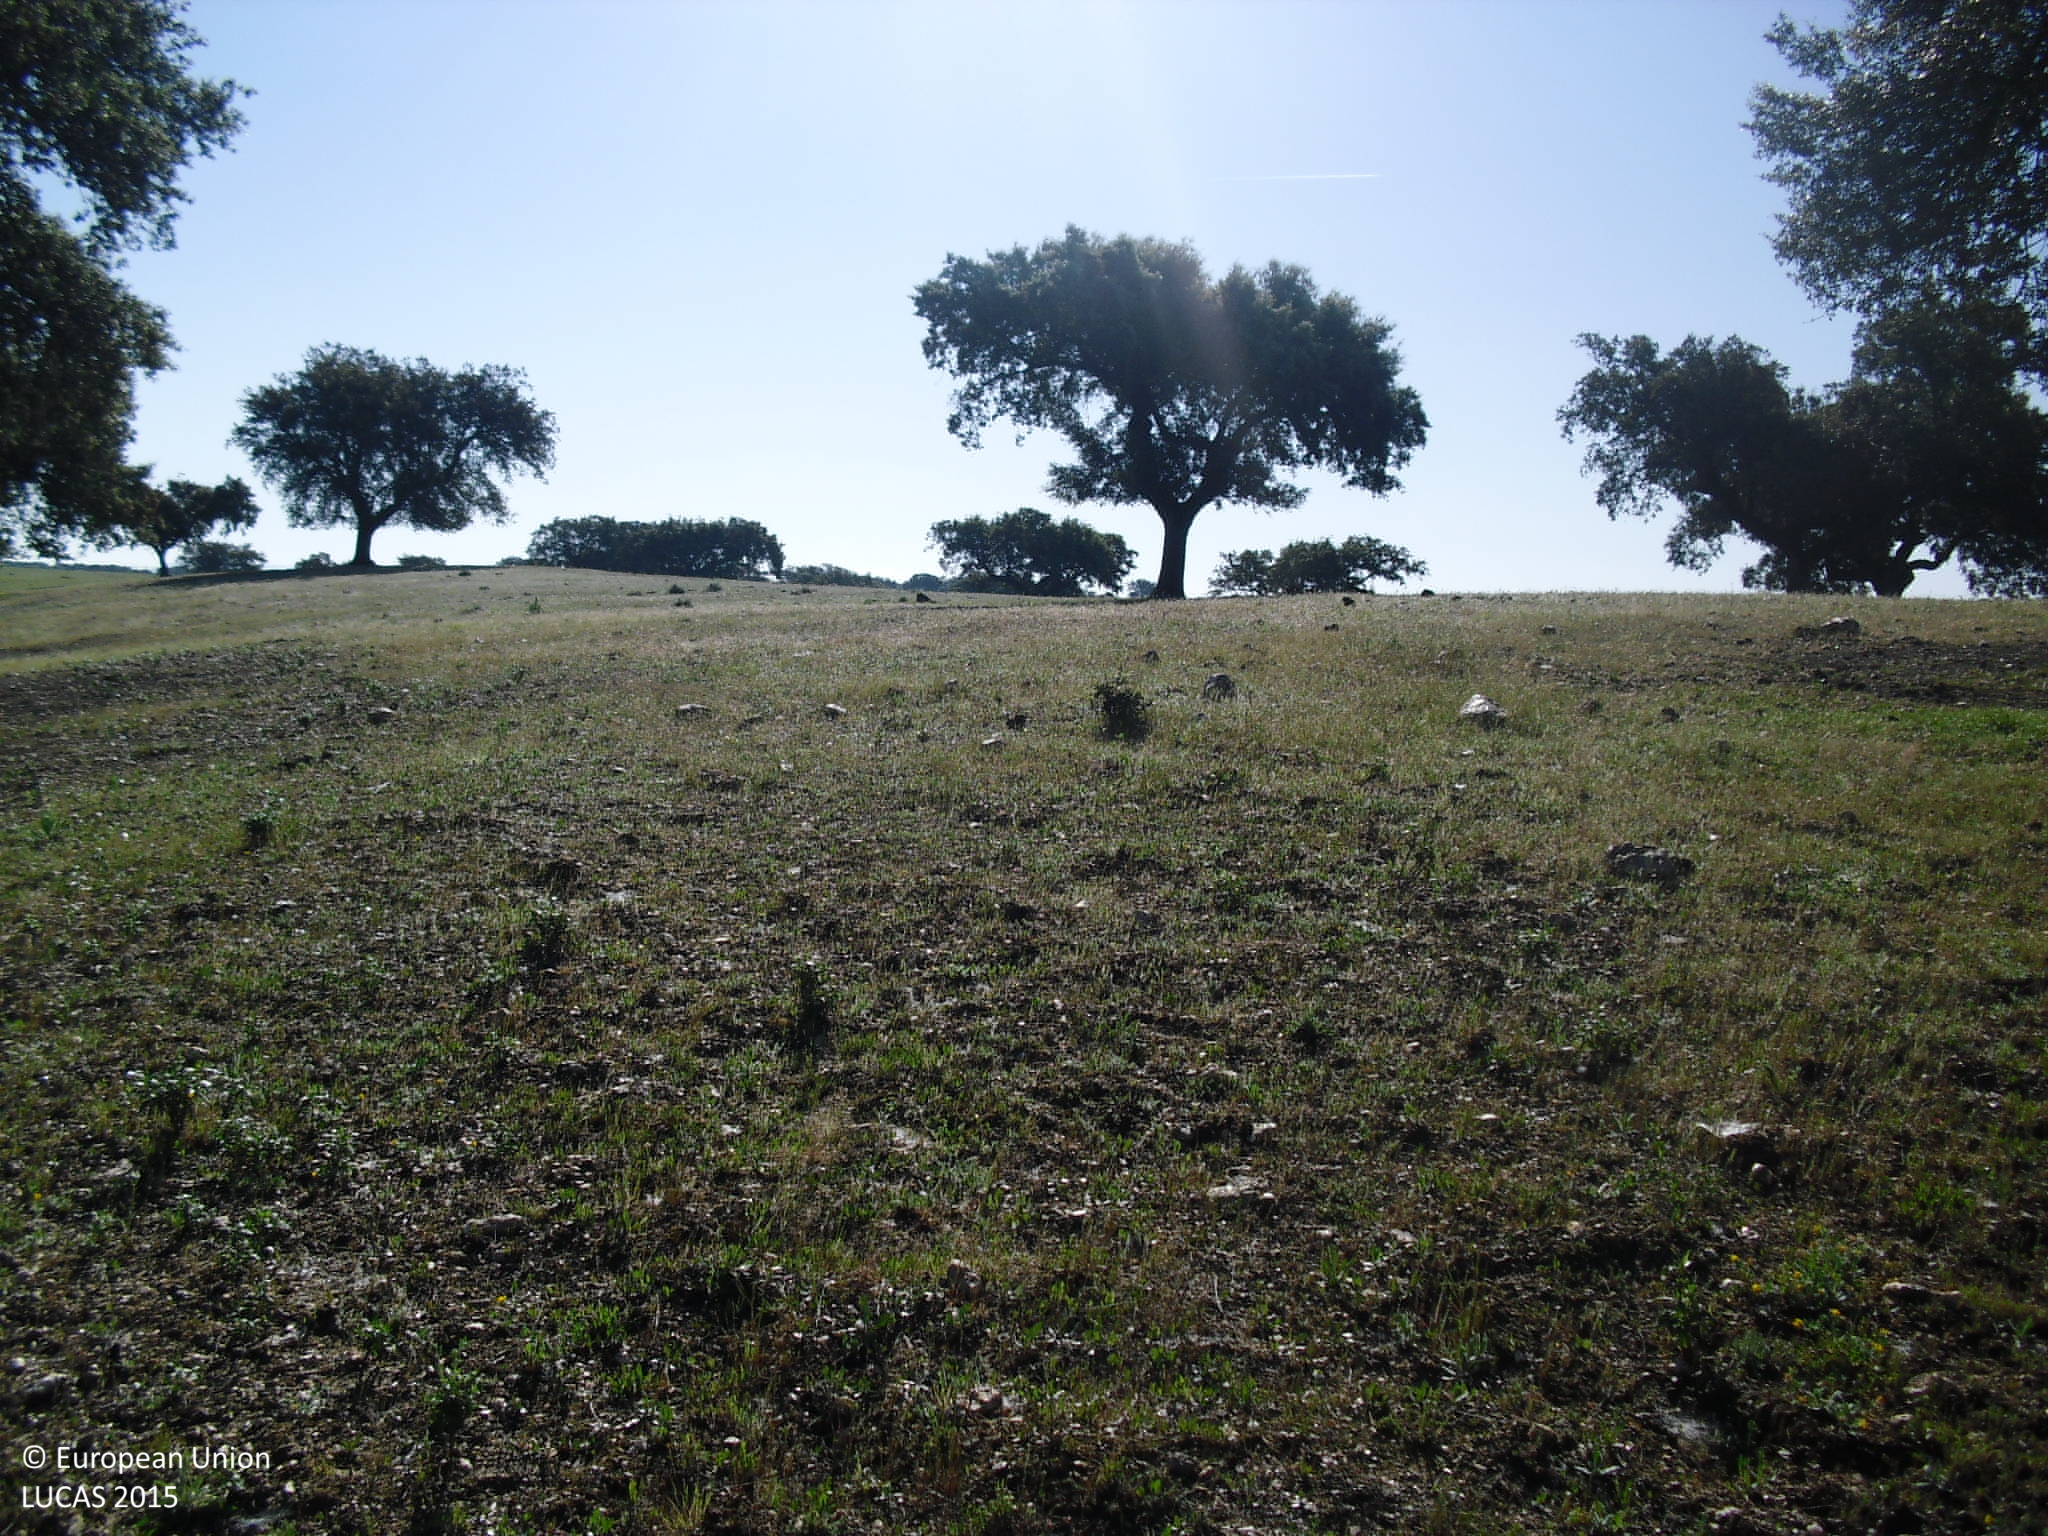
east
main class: Woodland
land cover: Broadleaved woodland
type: broadleaved evergreen forest
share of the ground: 10 - 25 %
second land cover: Spontaneously vegetated surfaces
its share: > 75 %
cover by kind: herbaceous plants 80 %, broadleaved forest trees 20 %
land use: Forestry
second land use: Agriculture (excluding fallow land and kitchen gardens)
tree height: > 5 m
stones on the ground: 10 - 25 %
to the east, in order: Broadleaved woodland; Spontaneously vegetated surfaces; Tracks; Grassland without tree/shrub cover
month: April
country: ES
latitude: 39.5932
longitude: -7.4559
